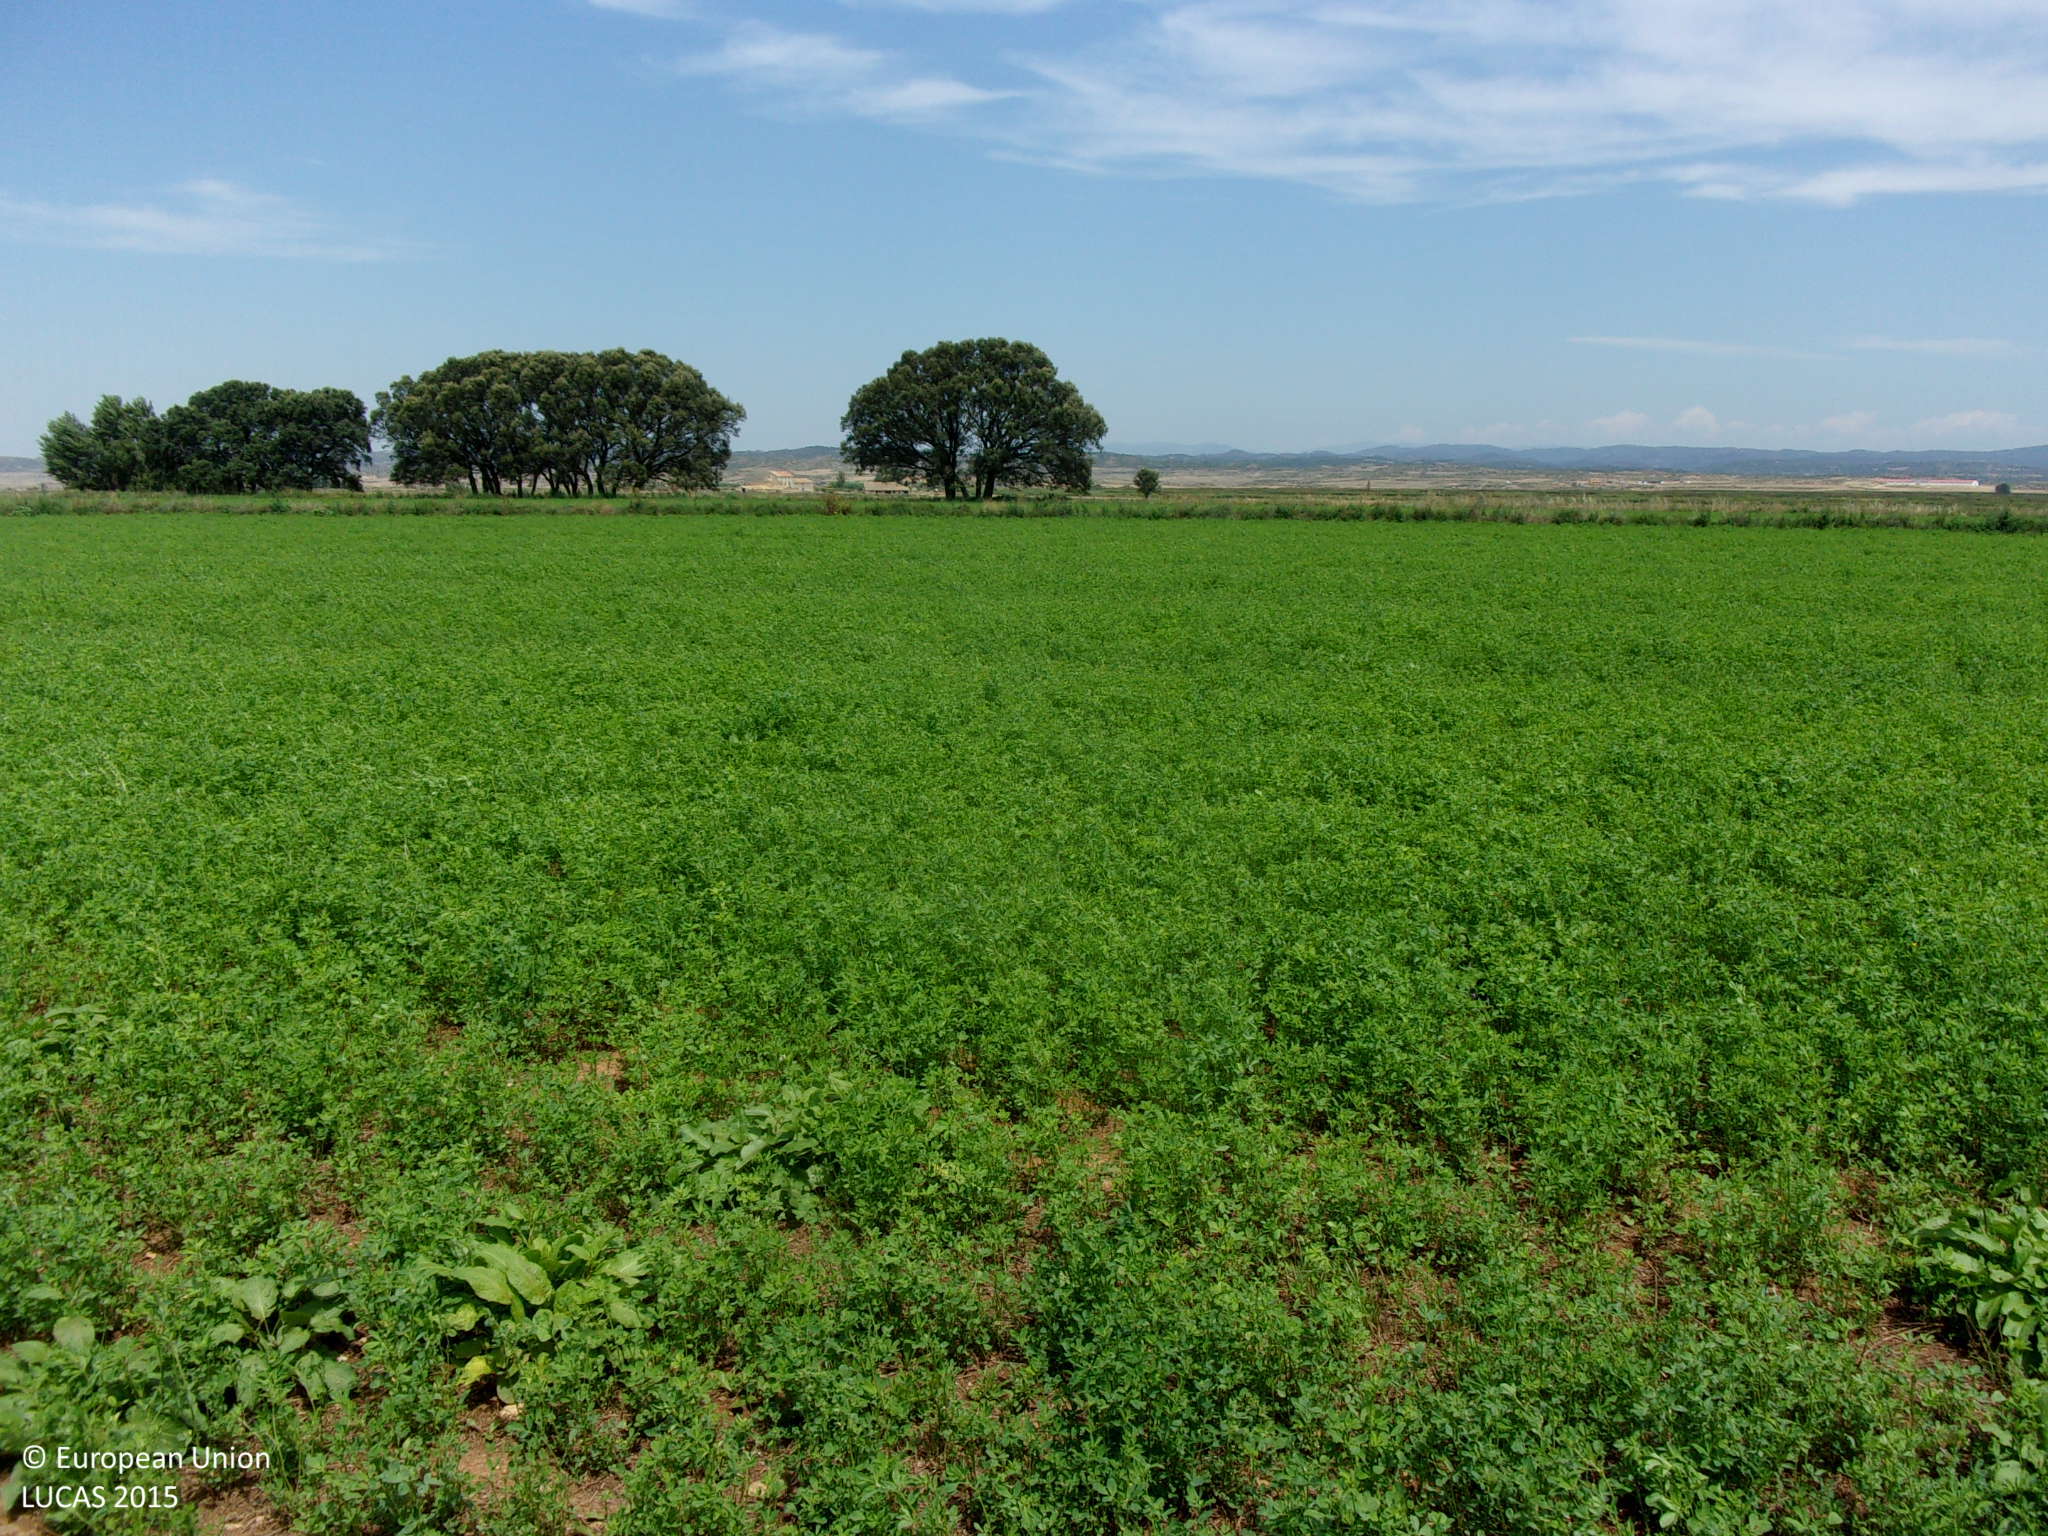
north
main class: Cropland
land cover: Lucerne
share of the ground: > 75 %
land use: Agriculture (excluding fallow land and kitchen gardens)
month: August
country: ES
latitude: 42.1208
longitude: -1.0465
